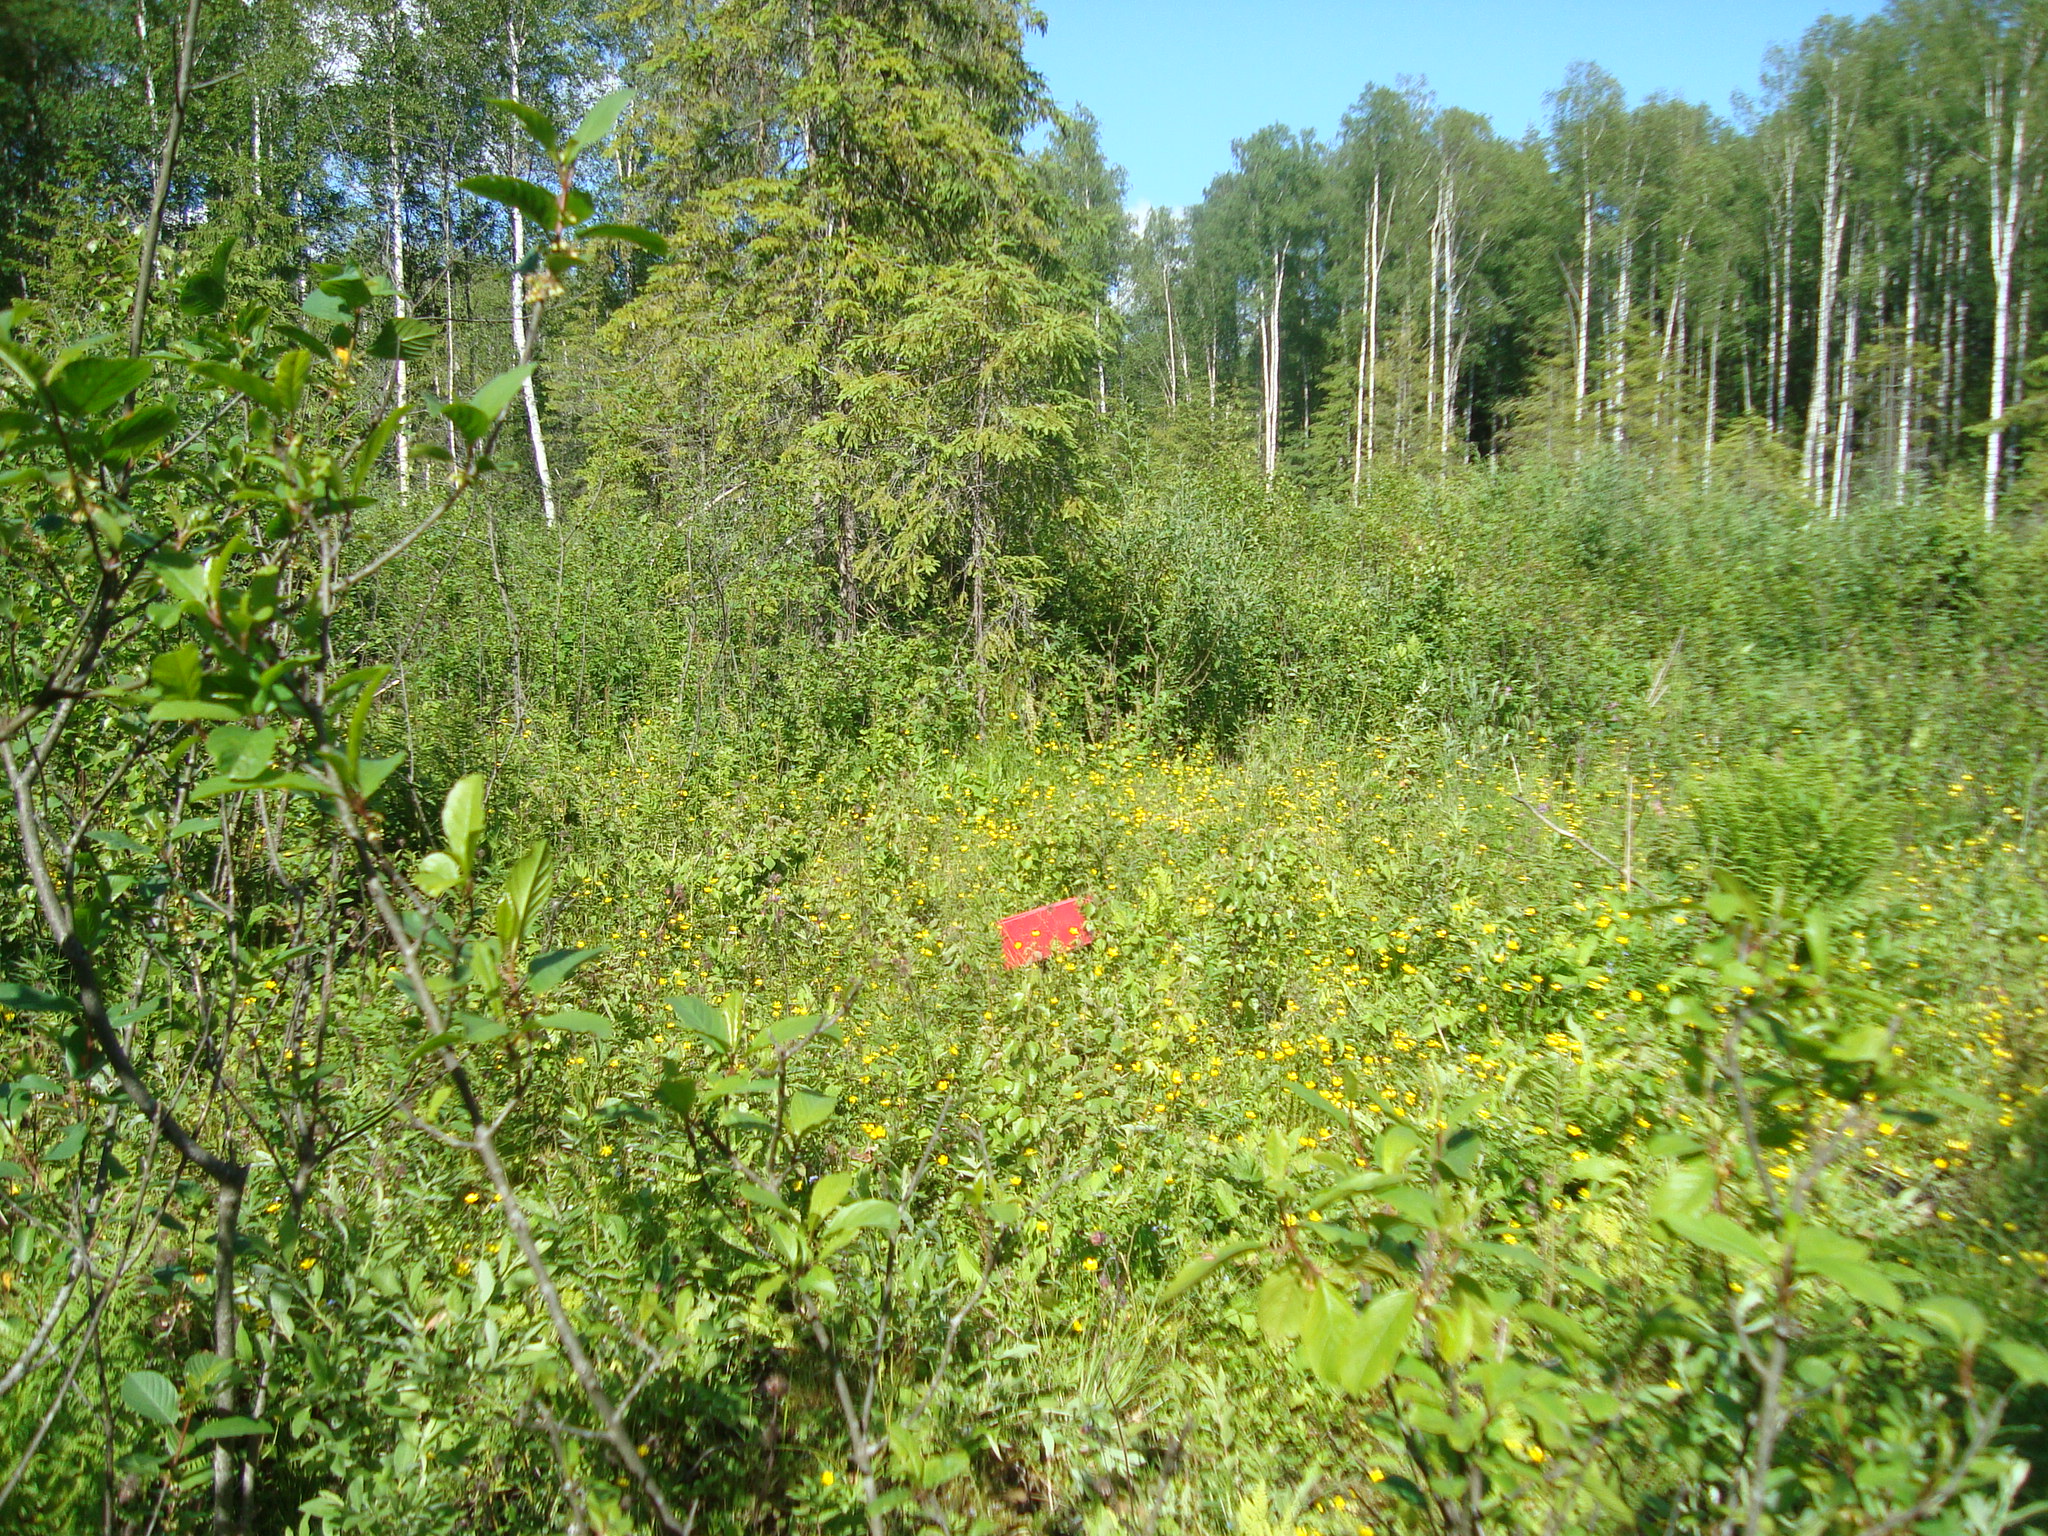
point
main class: Woodland
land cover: Spruce dominated mixed woodland
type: hemiboreal forest and nemoral coniferous forest and mixed broadleaved-coniferous forest
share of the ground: > 75 %
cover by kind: broadleaved forest trees 50 %, coniferous forest trees 30 %, shrubs 15 %, herbaceous plants 5 %
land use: Forestry
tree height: < 5 m
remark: Clear cut
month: June
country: LV
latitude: 56.6585
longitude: 25.7377
